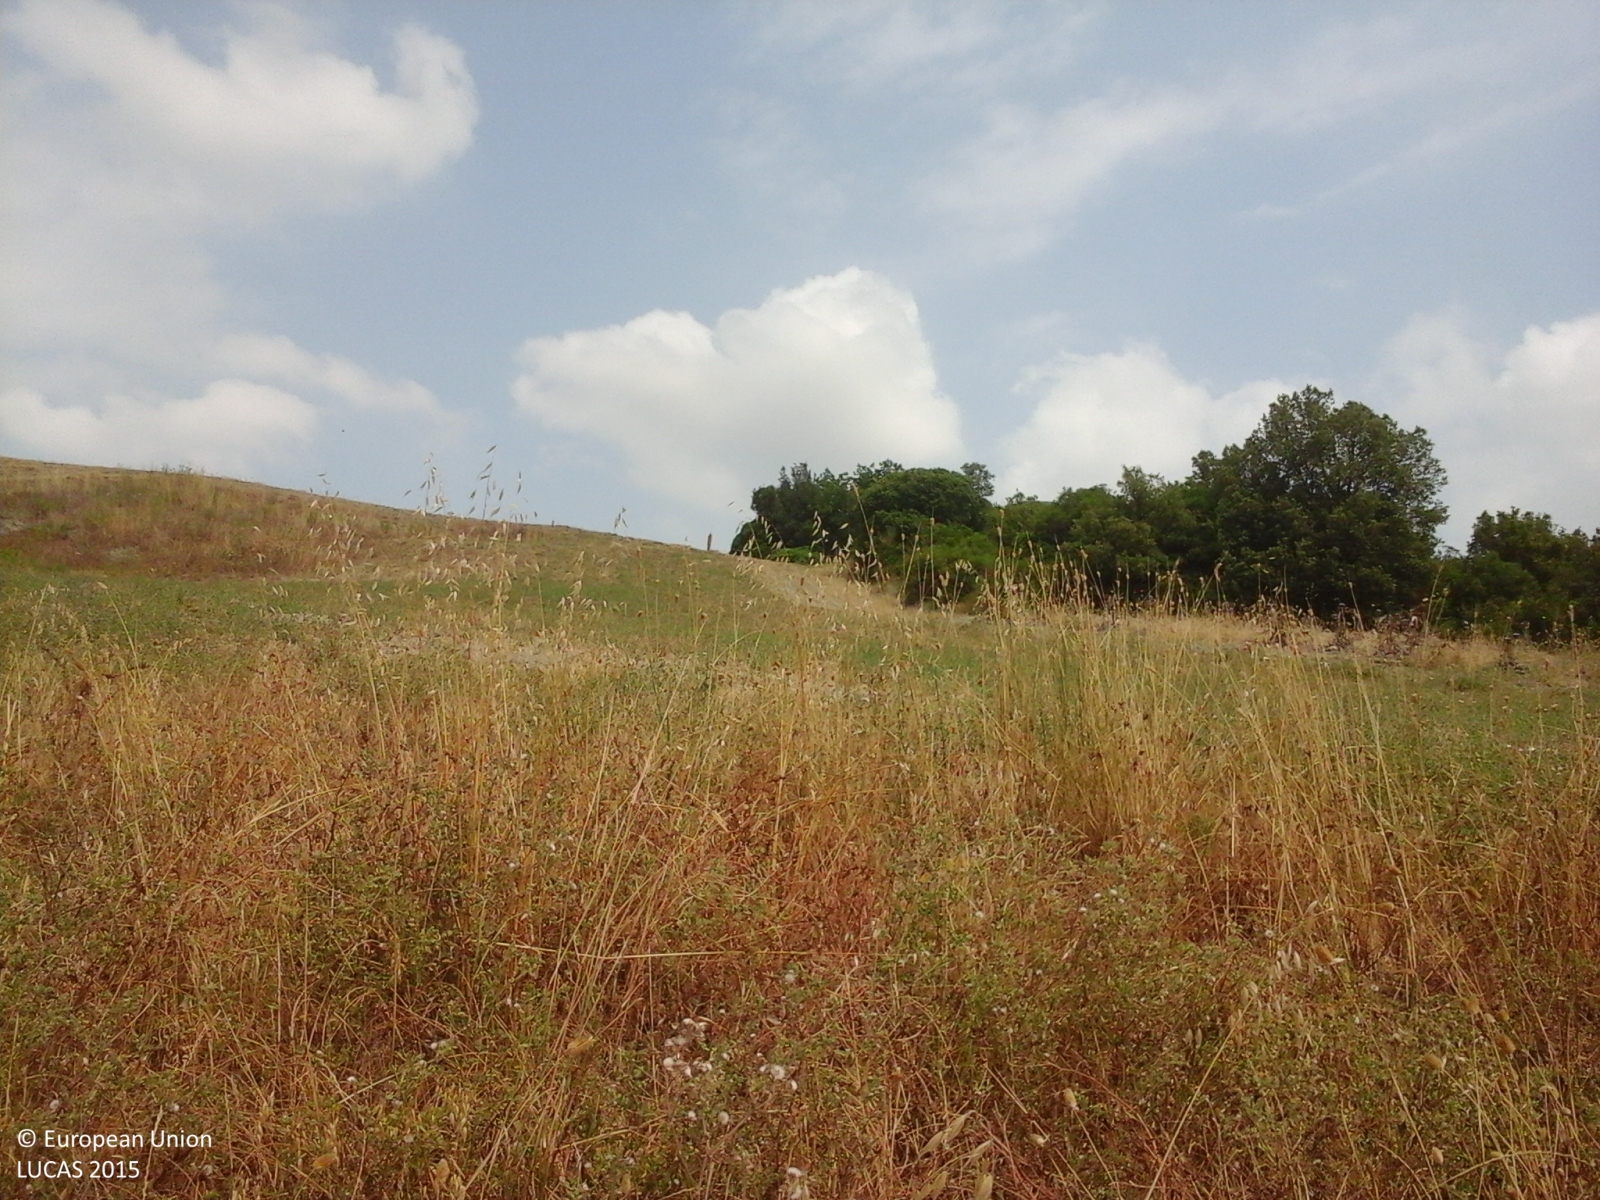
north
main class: Cropland
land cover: Oats
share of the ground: > 75 %
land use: Agriculture (excluding fallow land and kitchen gardens)
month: July
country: IT
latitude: 43.3719
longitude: 10.9475
